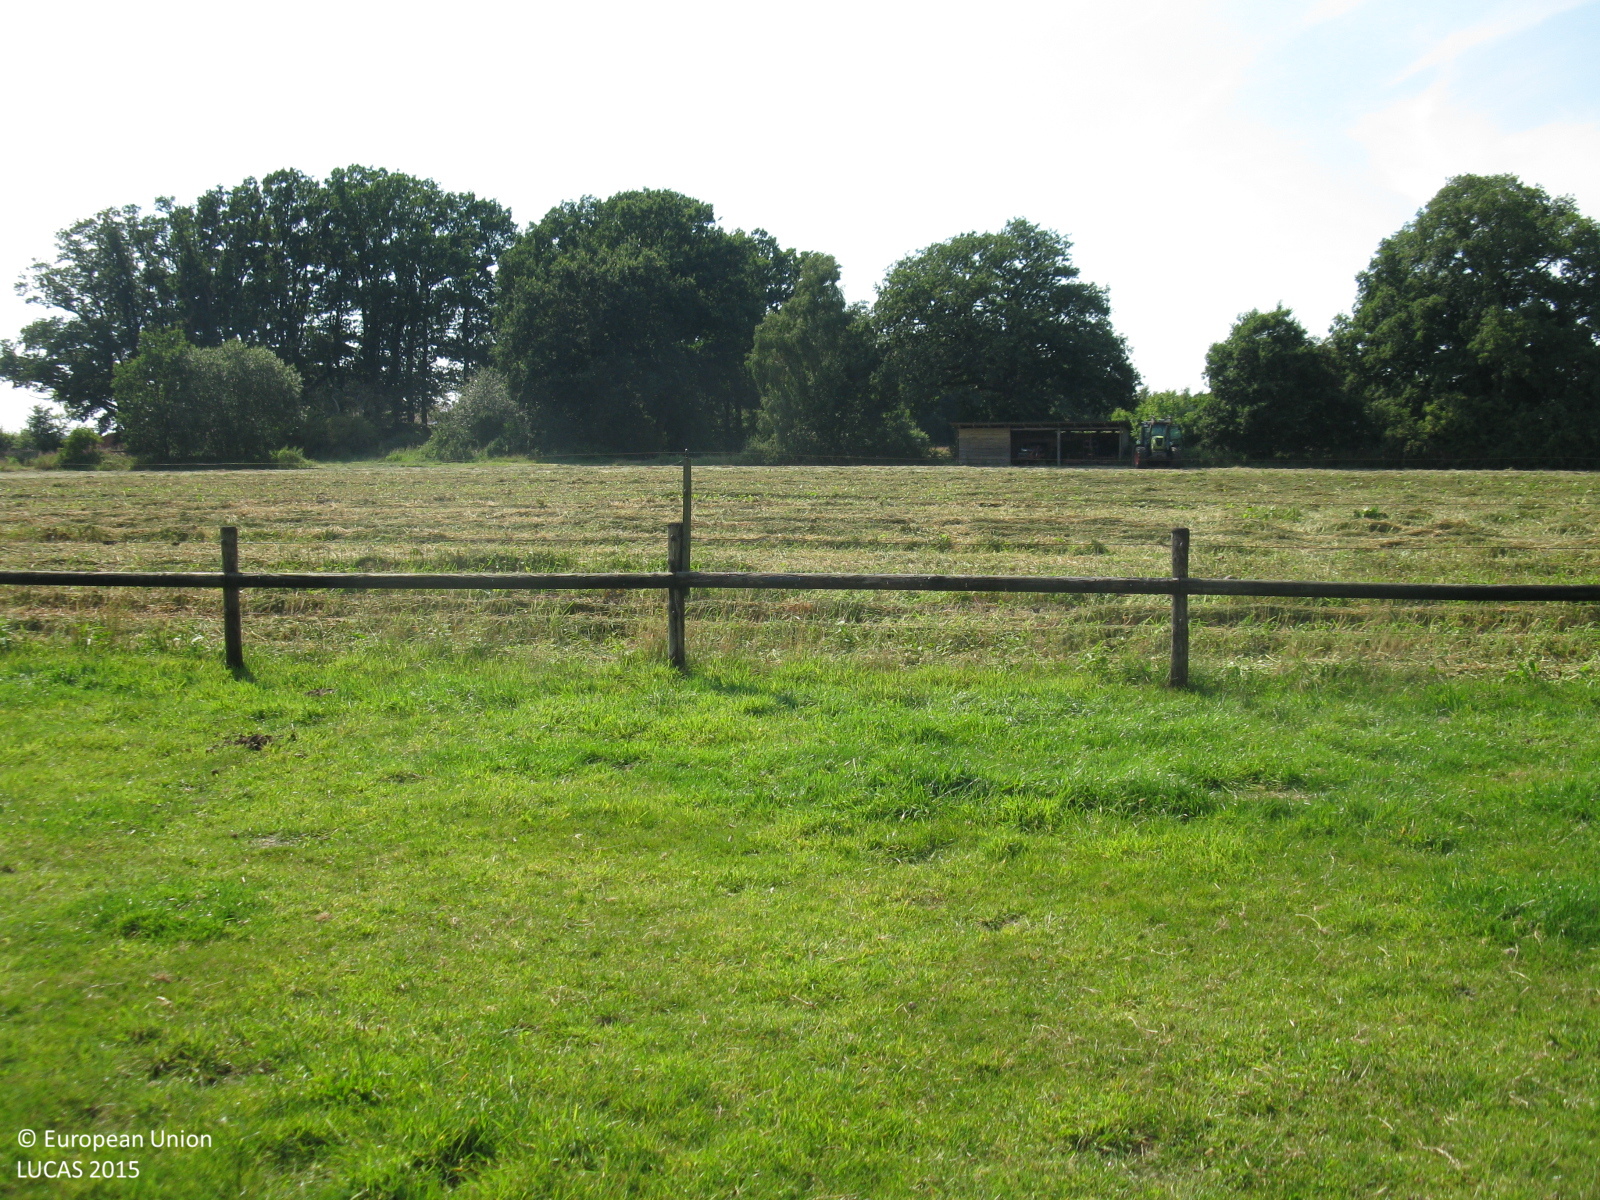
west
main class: Grassland
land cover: Grassland without tree/shrub cover
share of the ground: > 75 %
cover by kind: herbaceous plants 100 %
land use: Agriculture (excluding fallow land and kitchen gardens)
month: August
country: DE
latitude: 53.0131
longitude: 8.3461
